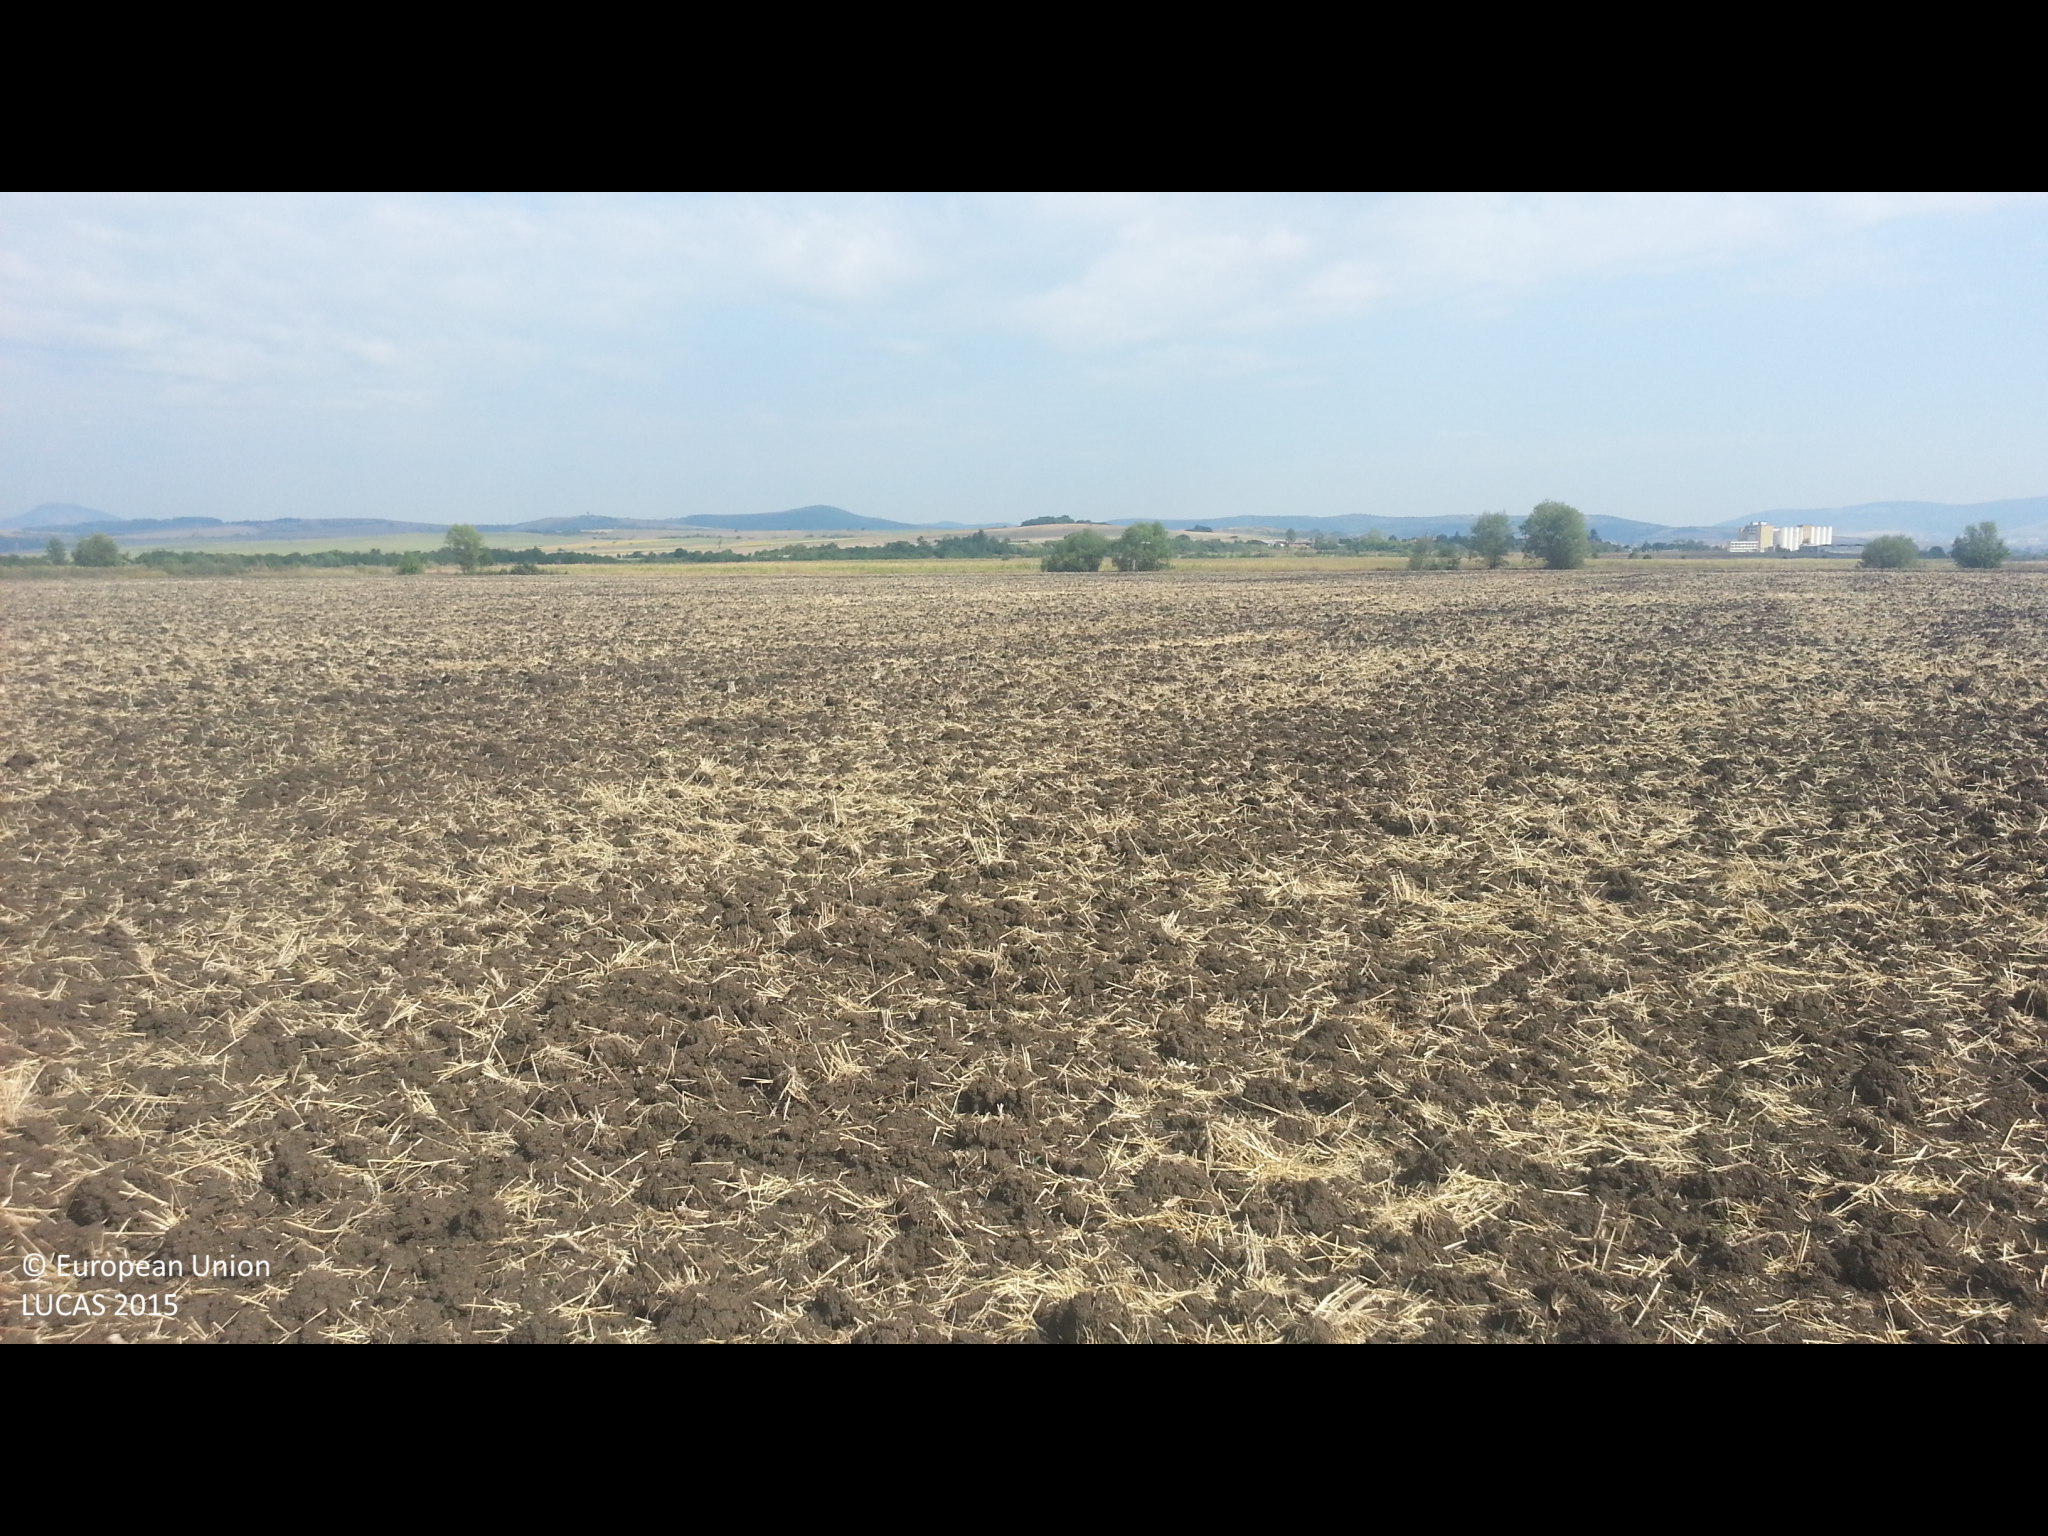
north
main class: Cropland
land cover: Common wheat
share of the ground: < 10 %
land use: Agriculture (excluding fallow land and kitchen gardens)
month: August
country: BG
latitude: 42.4461
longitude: 22.9014
